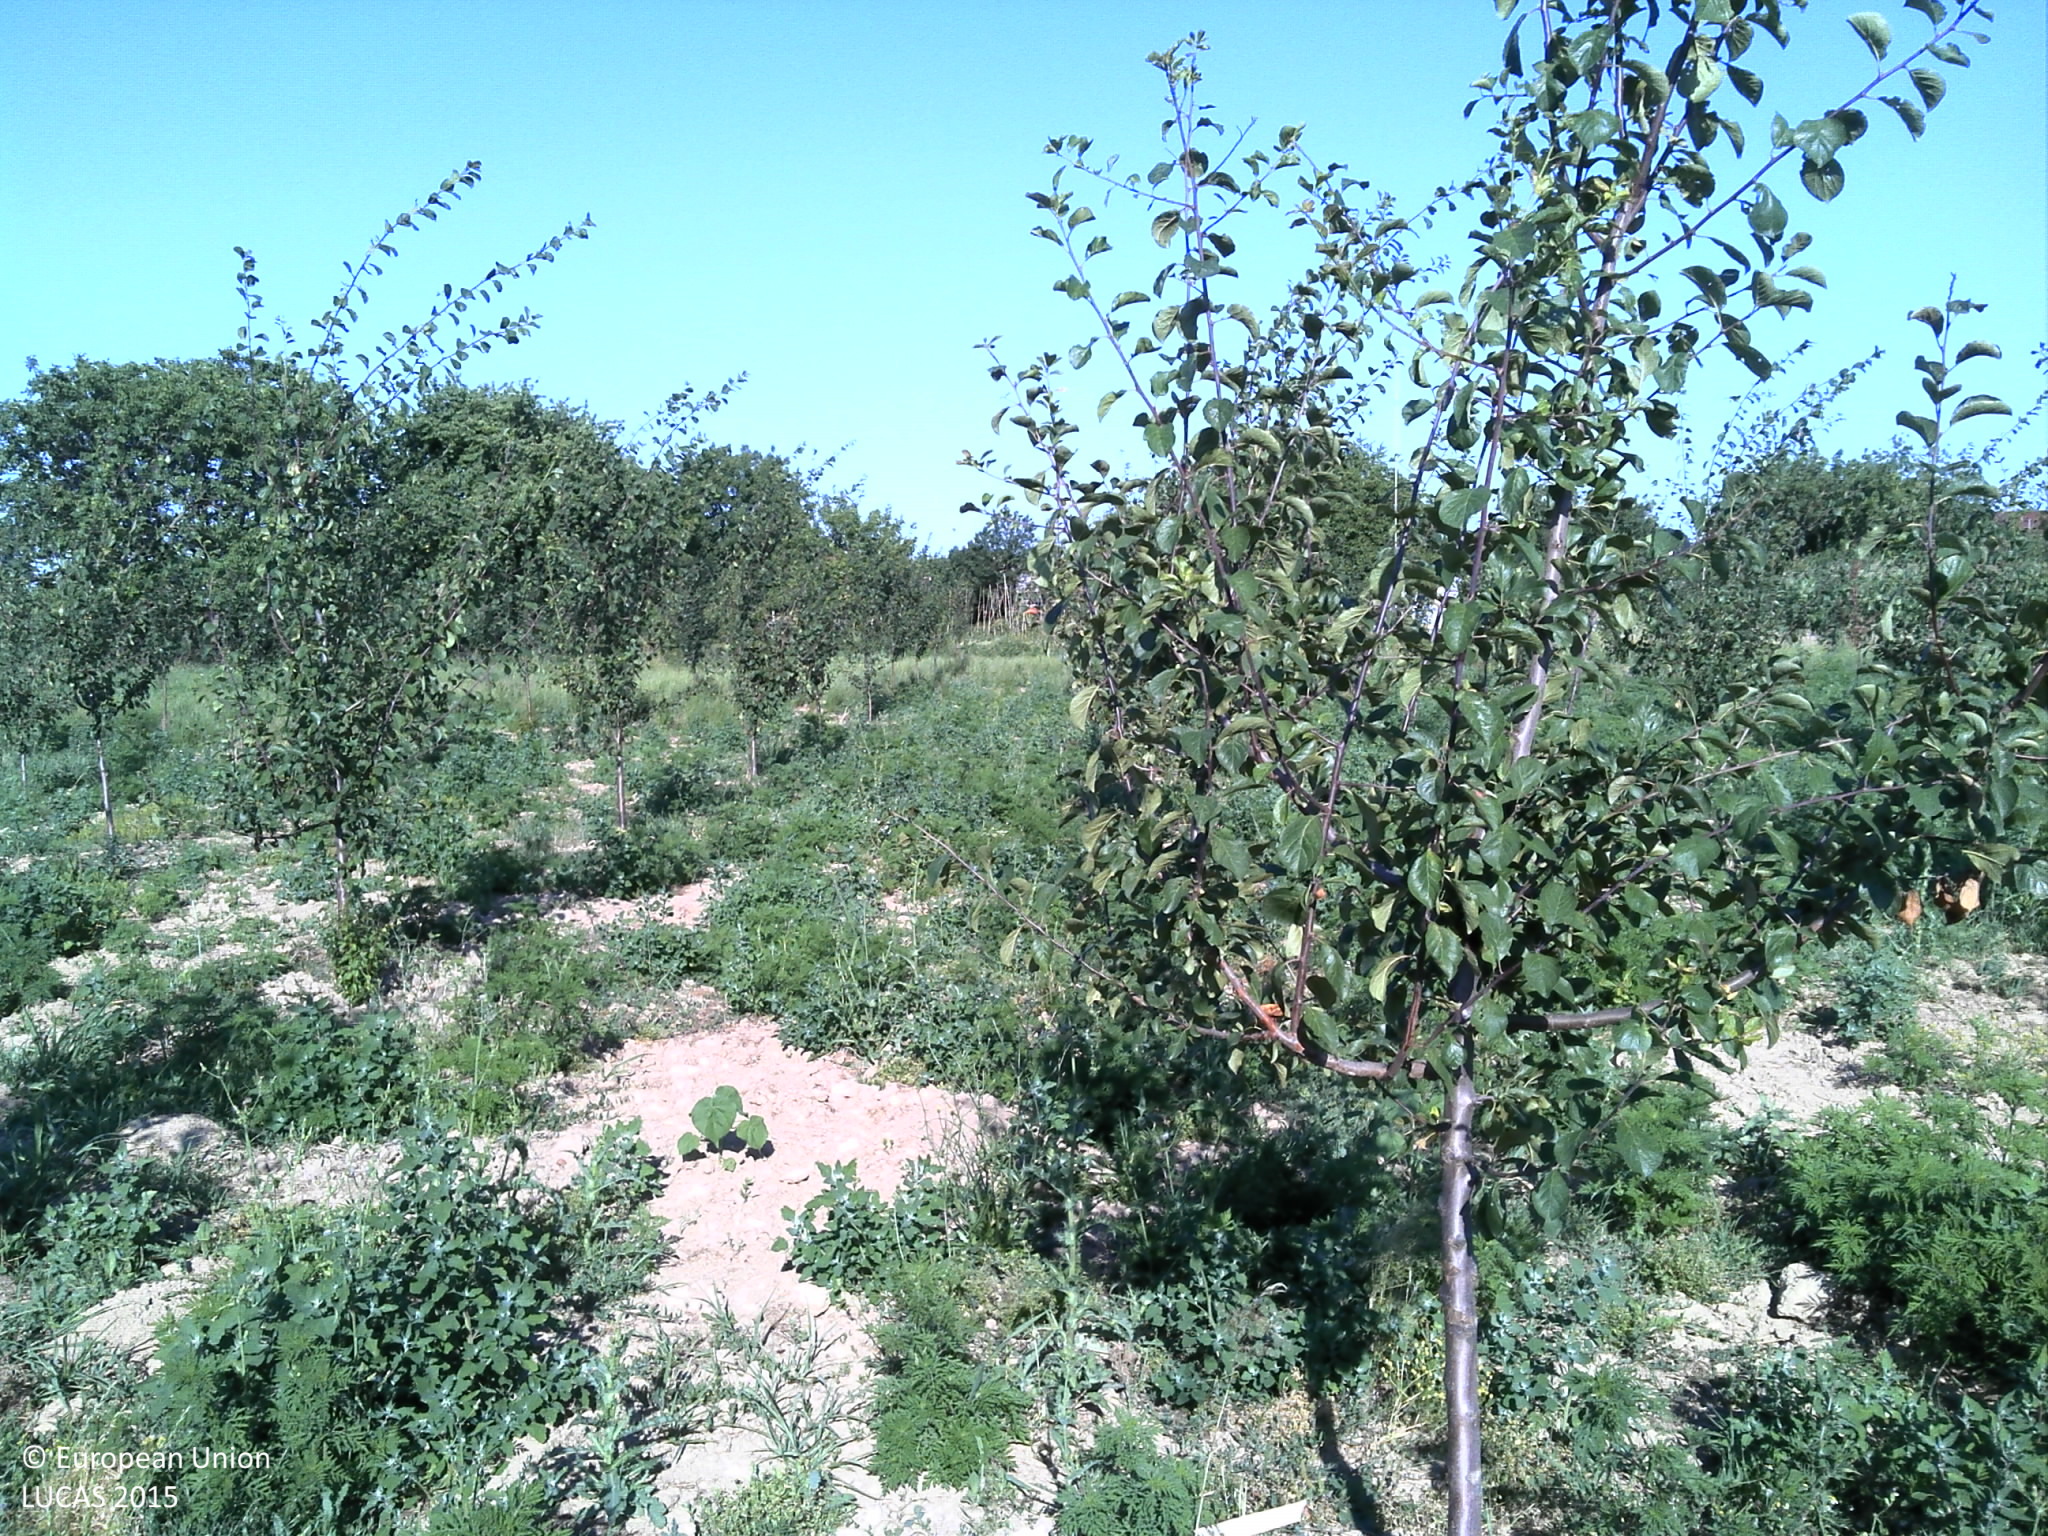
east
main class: Cropland
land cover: Other fruit trees and berries
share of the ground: 10 - 25 %
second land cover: Spontaneously vegetated surfaces
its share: 25 - 50 %
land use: Agriculture (excluding fallow land and kitchen gardens)
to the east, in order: Other fruit trees and berries; Spontaneously vegetated surfaces; Artificial constructions in urban areas
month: July
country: HR
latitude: 45.2953
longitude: 18.4082
